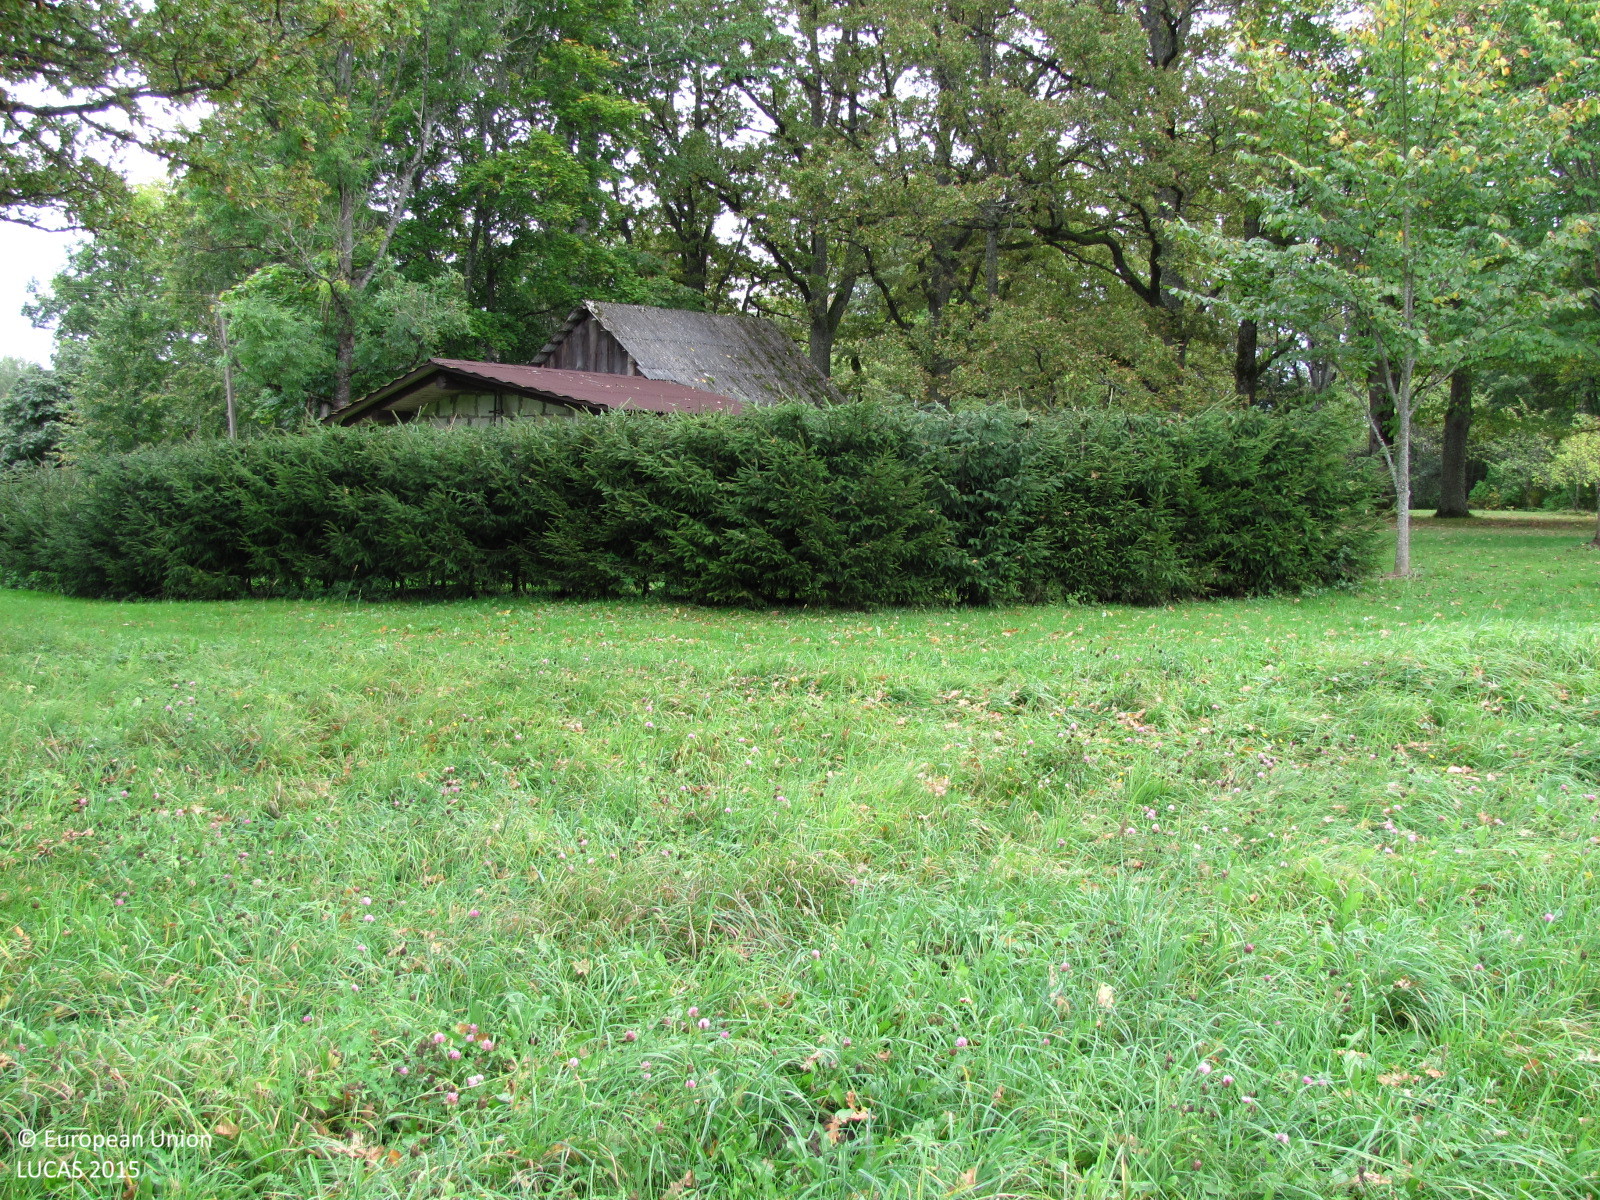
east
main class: Grassland
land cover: Grassland without tree/shrub cover
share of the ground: > 75 %
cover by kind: herbaceous plants 100 %
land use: Agriculture (excluding fallow land and kitchen gardens)
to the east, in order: Grassland without tree/shrub cover; Artificial constructions in urban areas; Broadleaved woodland; Artificial constructions in urban areas; Grassland without tree/shrub cover; Broadleaved woodland; Grassland without tree/shrub cover; Fences; Grassland without tree/shrub cover; Broadleaved woodland
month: September
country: LV
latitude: 56.8191
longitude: 25.1664
